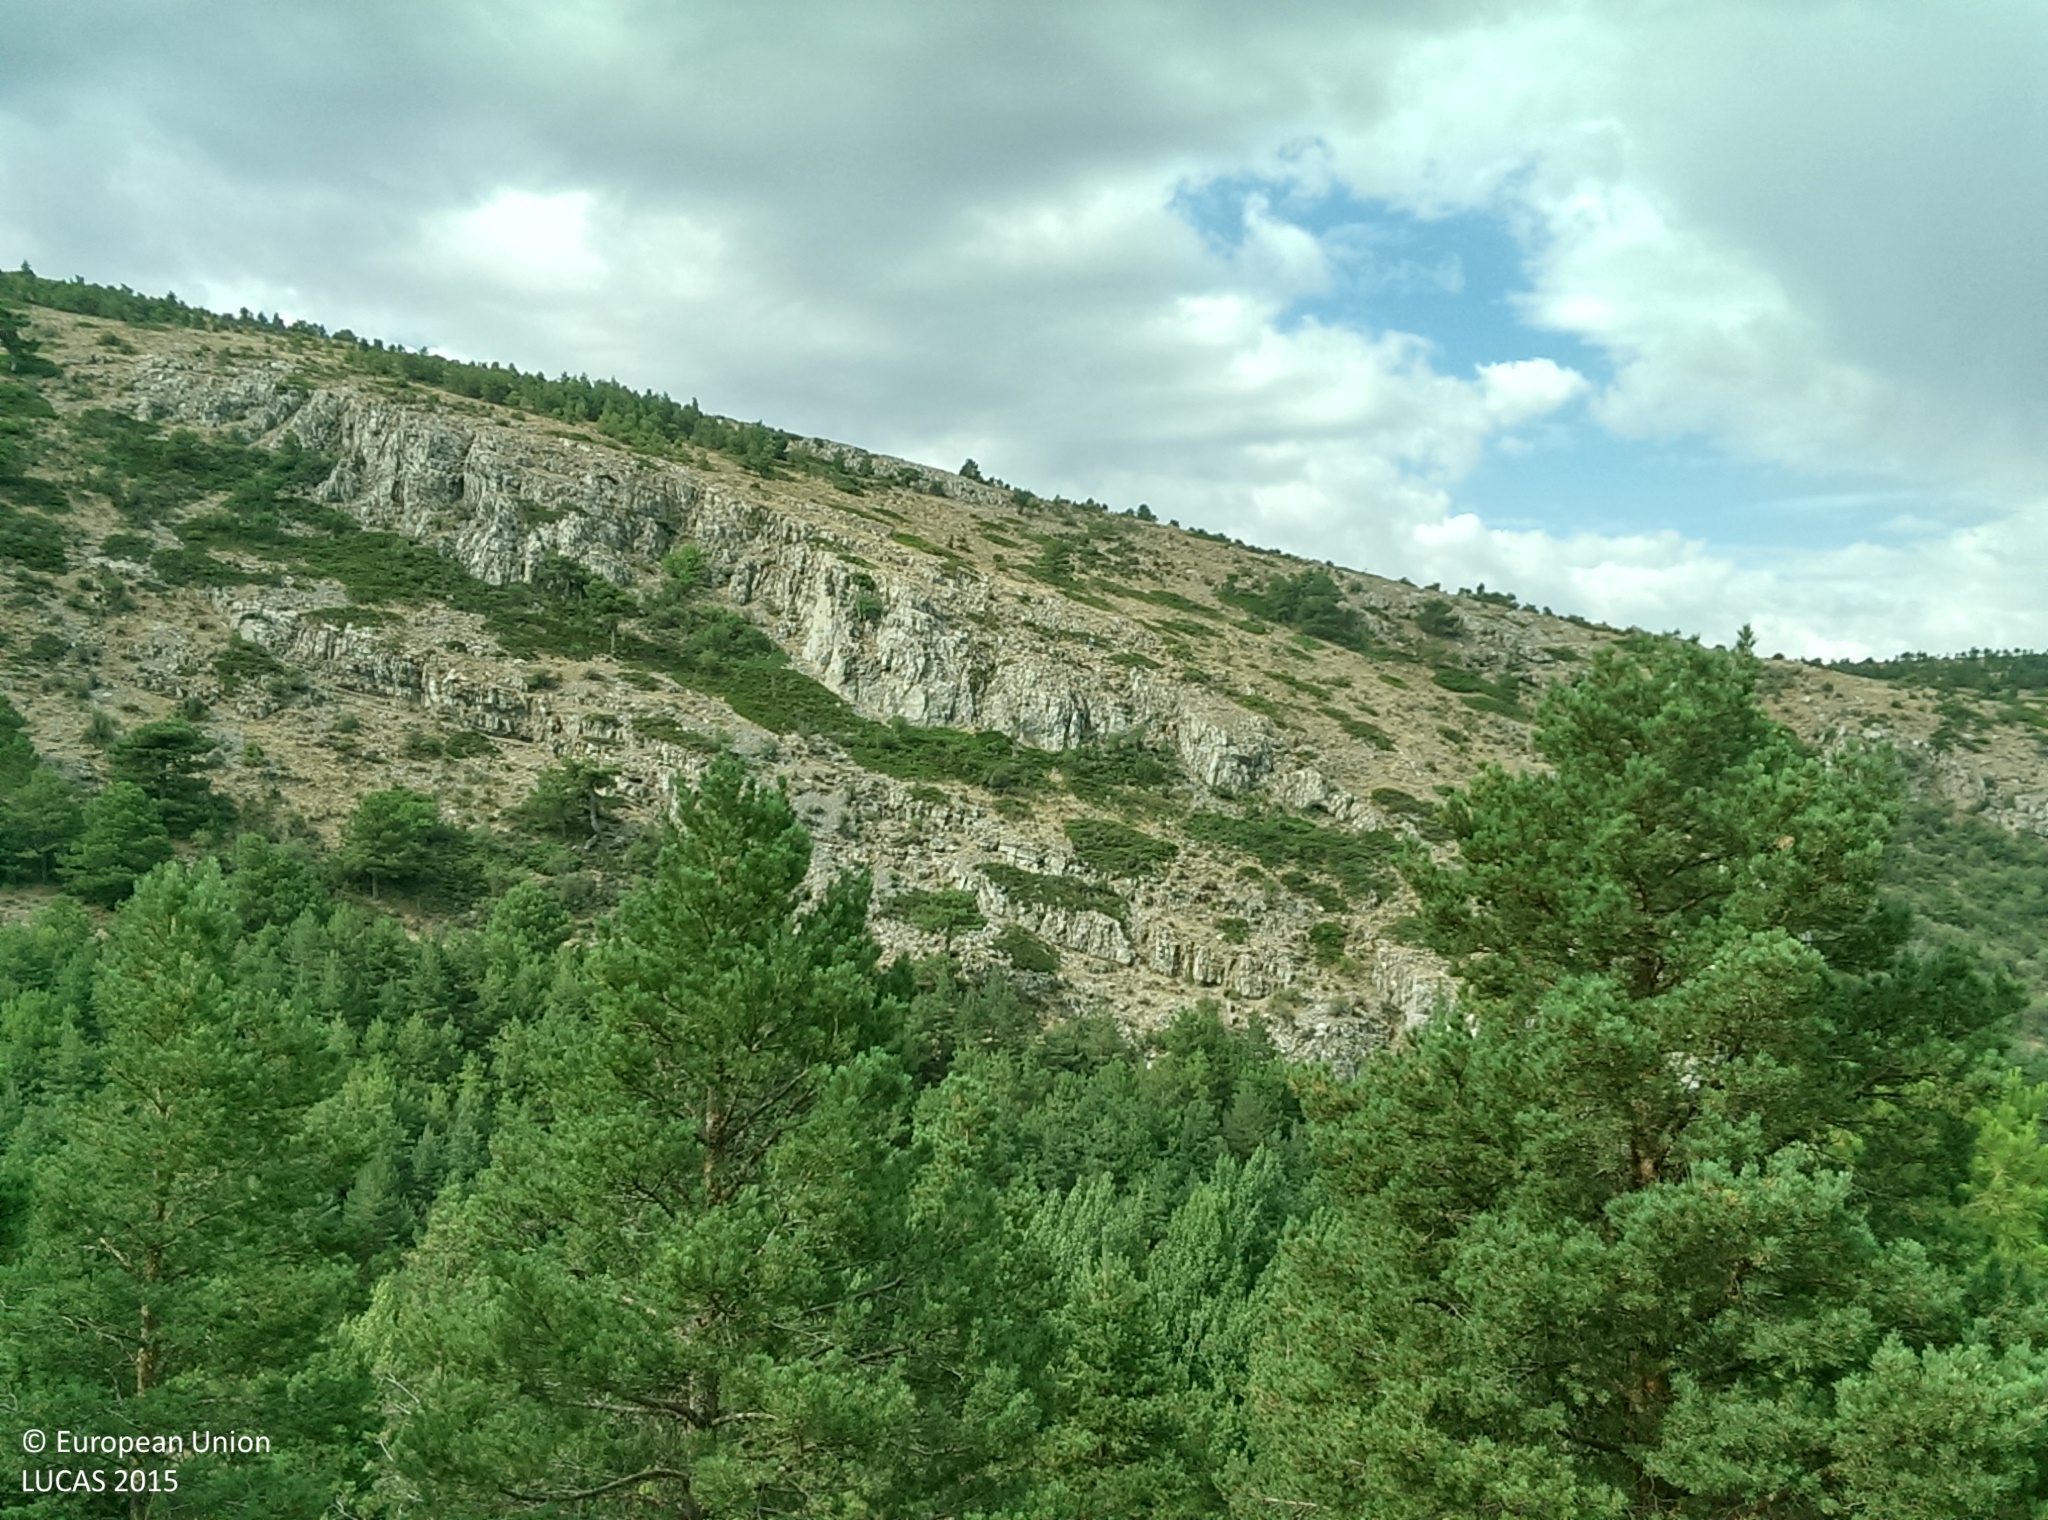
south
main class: Woodland
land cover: Pine dominated coniferous woodland
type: coniferous forest of the mediterranean region
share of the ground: 10 - 25 %
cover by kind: shrubs 40 %, herbaceous plants 20 %, coniferous forest trees 15 %, consolidated bare surface 15 %, unconsolidated bare surface 10 %
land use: Forestry
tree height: > 5 m
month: July
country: ES
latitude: 37.3077
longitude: -2.8812
